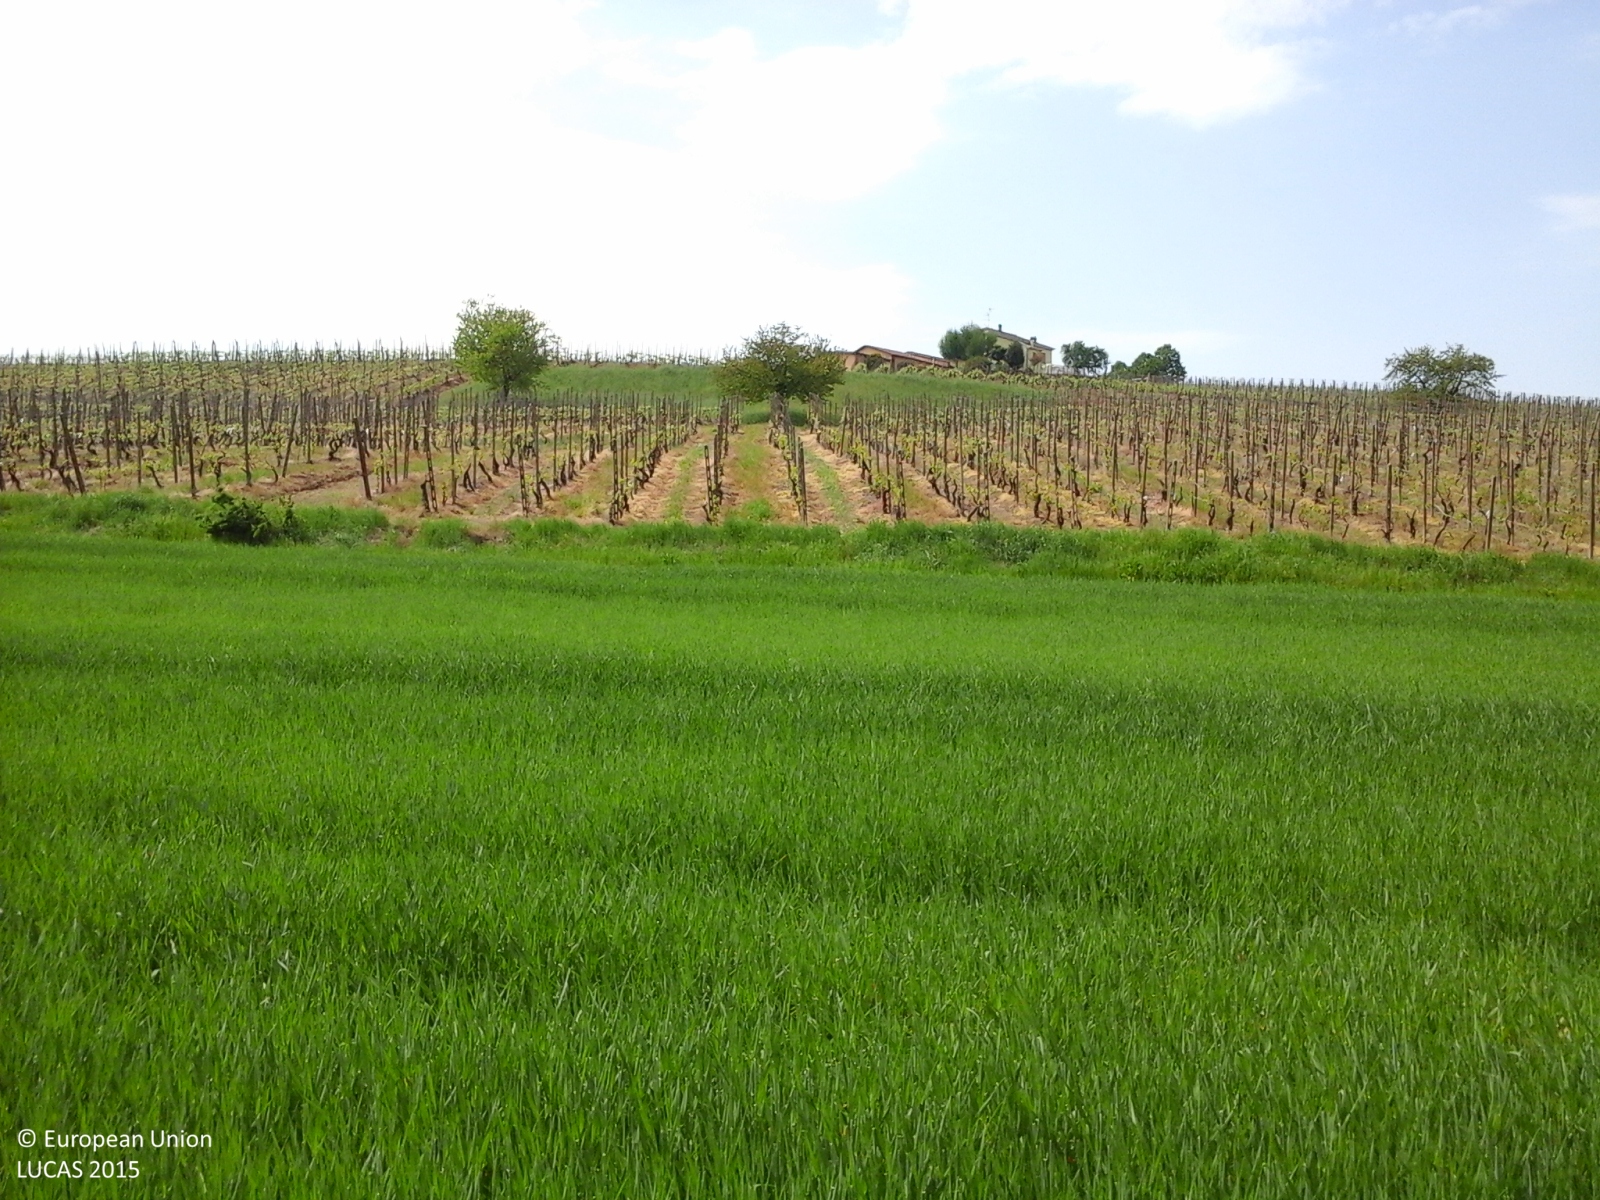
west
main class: Cropland
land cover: Common wheat
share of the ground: > 75 %
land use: Agriculture (excluding fallow land and kitchen gardens)
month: April
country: IT
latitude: 45.0160
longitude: 9.4048
